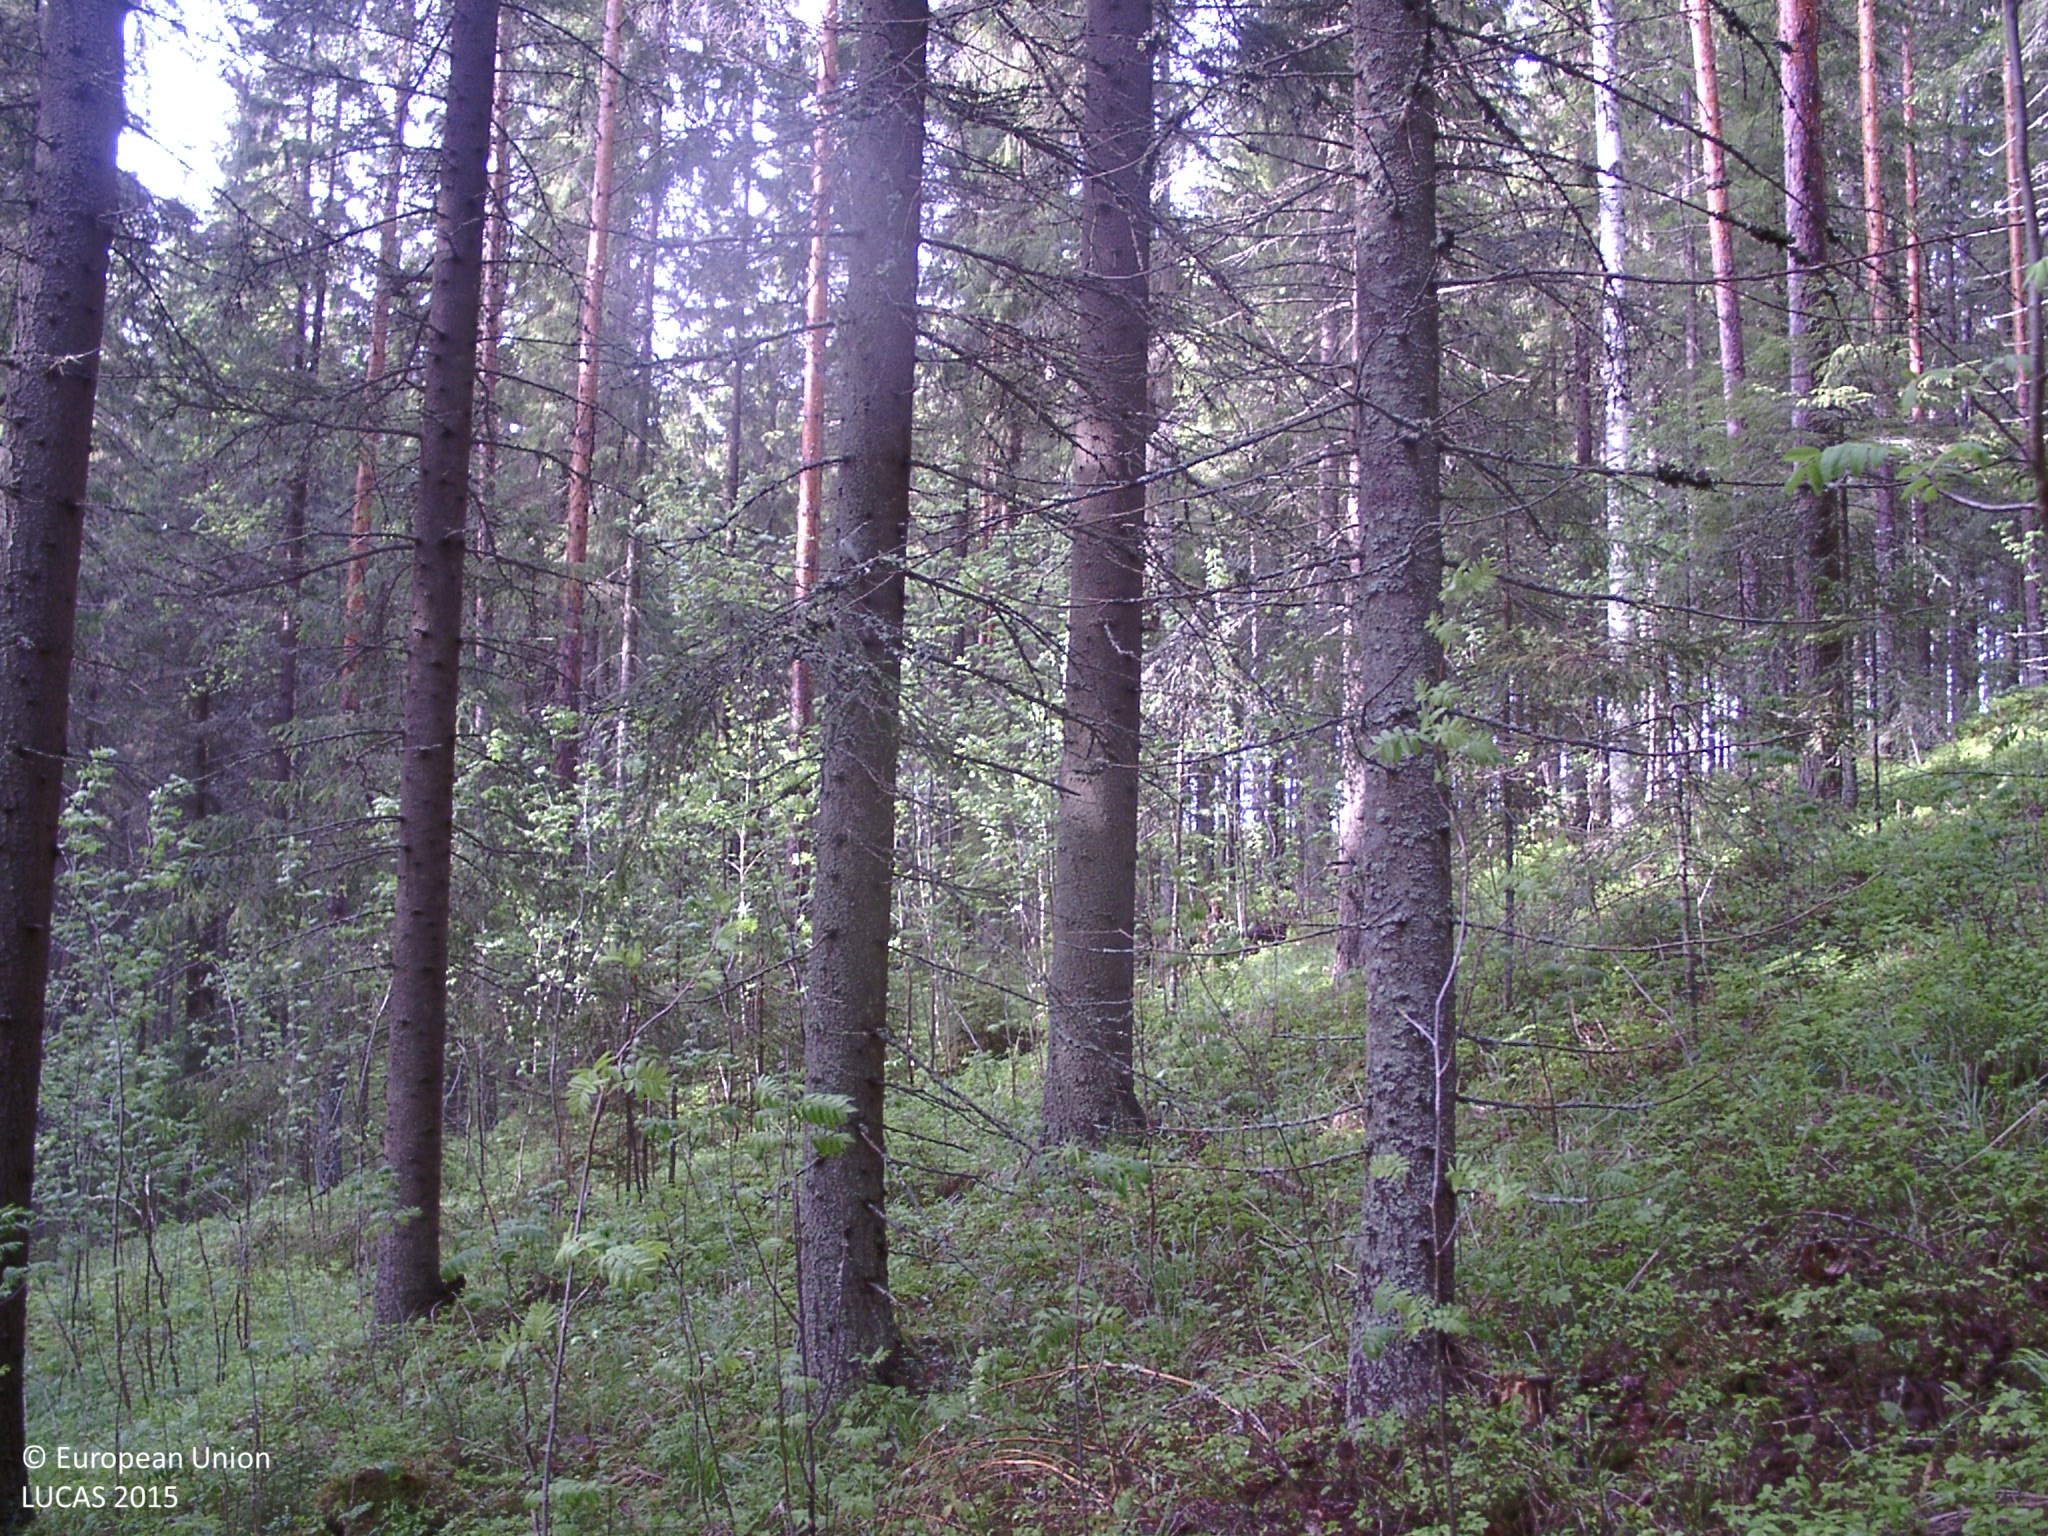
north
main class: Woodland
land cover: Spruce dominated coniferous woodland
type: boreal forest
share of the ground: 50 - 75 %
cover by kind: coniferous forest trees 65 %, shrubs 15 %, herbaceous plants 10 %, broadleaved forest trees 5 %, lichens and mosses 5 %
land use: Forestry
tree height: > 5 m
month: June
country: FI
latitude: 62.1891
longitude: 25.5045
